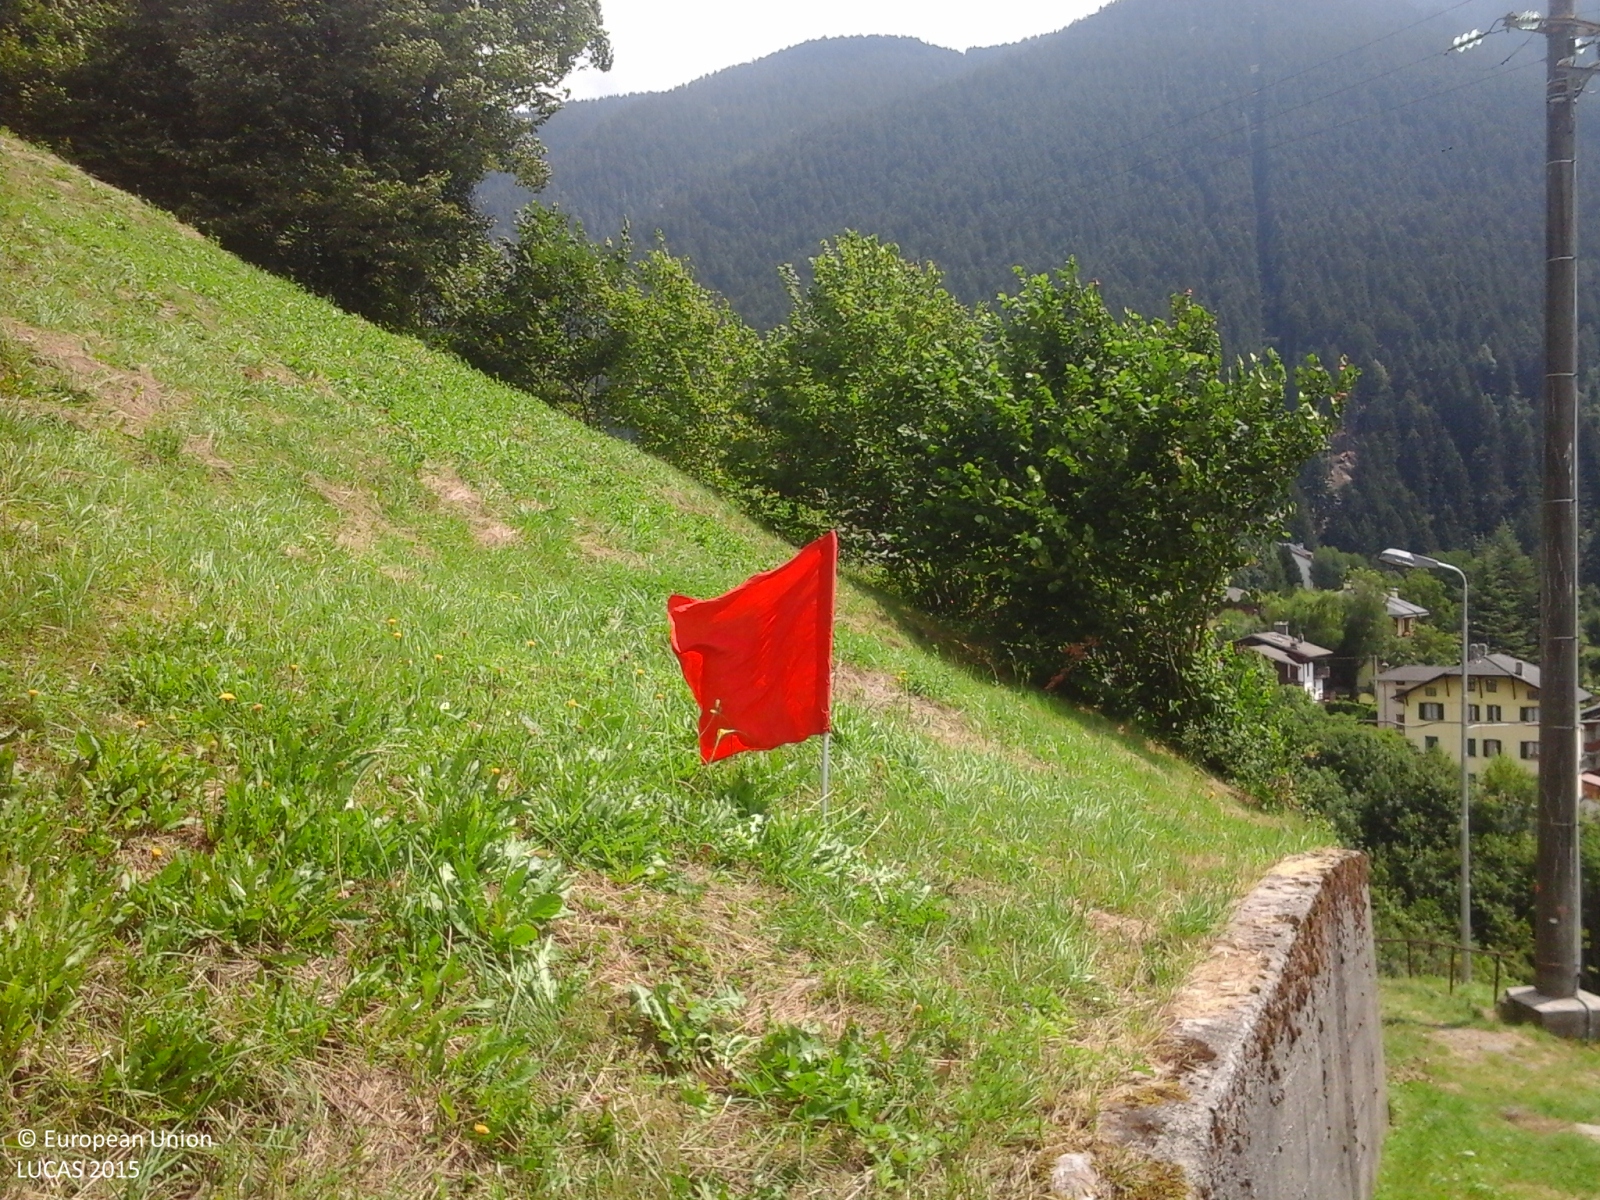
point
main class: Grassland
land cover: Grassland without tree/shrub cover
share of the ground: > 75 %
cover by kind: herbaceous plants 100 %
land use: Agriculture (excluding fallow land and kitchen gardens)
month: July
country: IT
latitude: 45.9904
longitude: 9.6777
